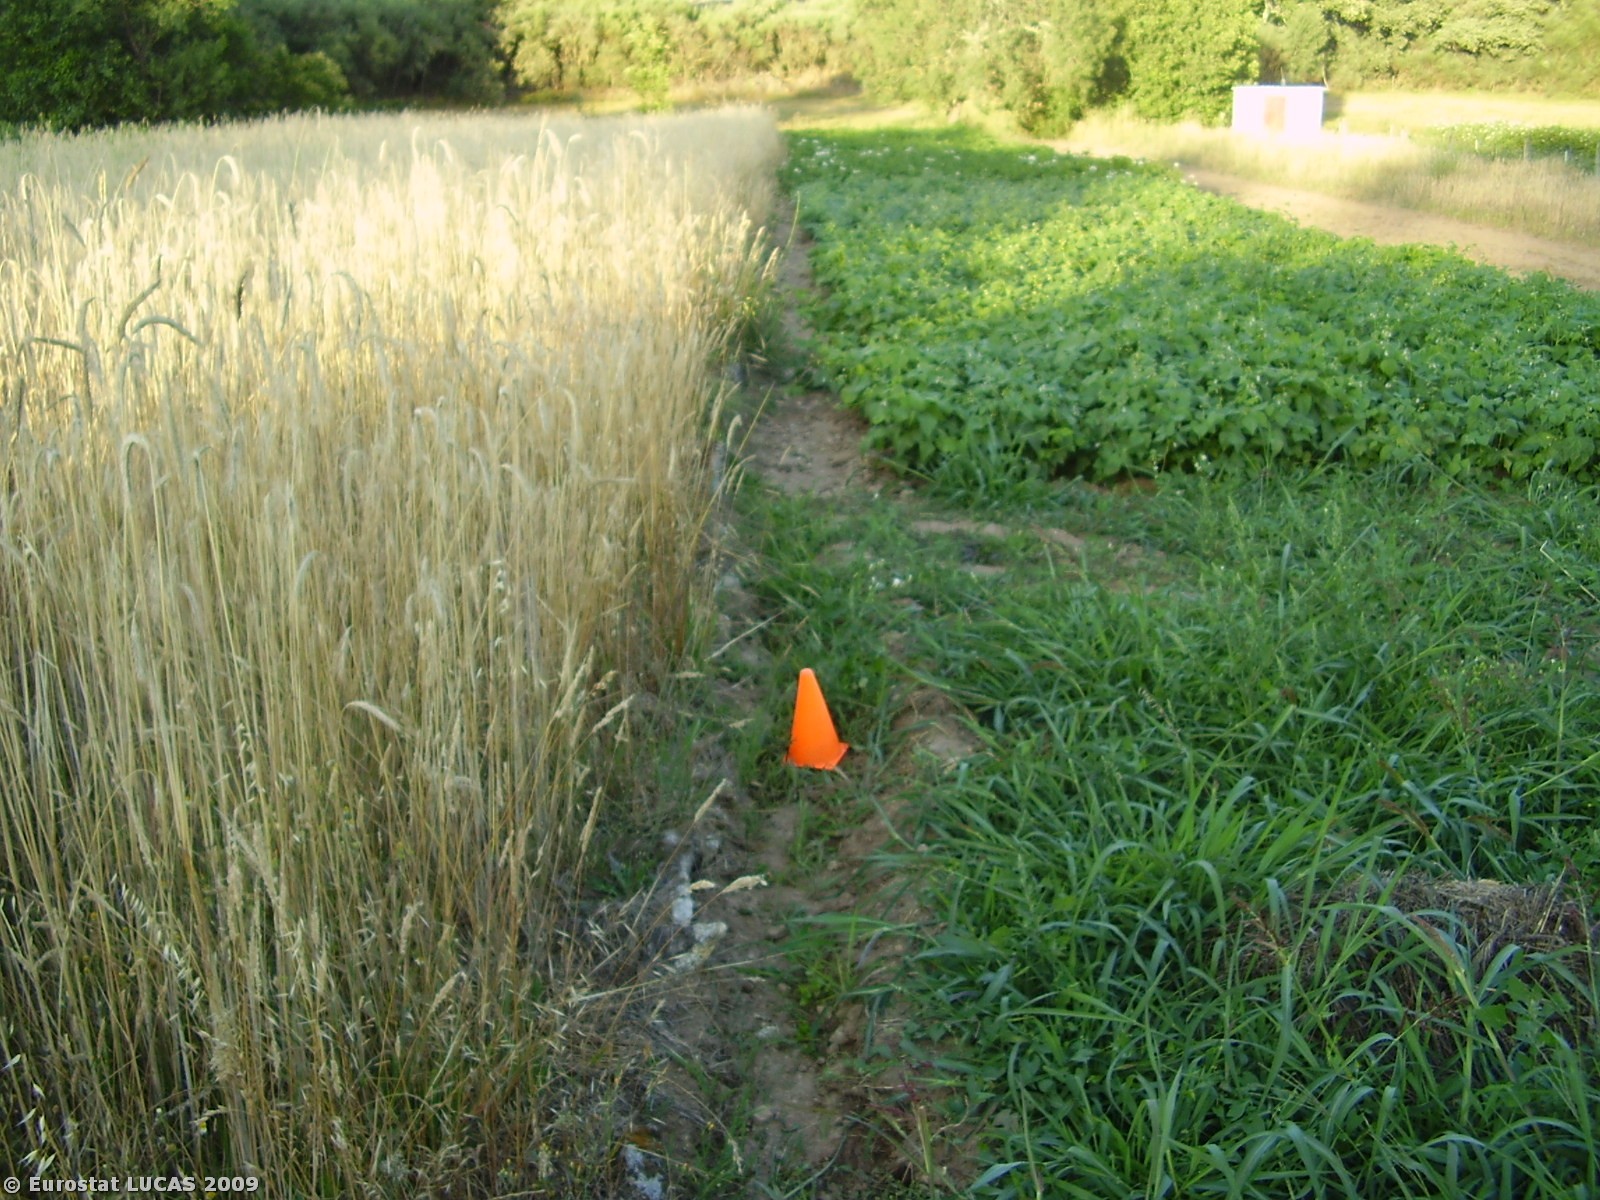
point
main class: Cropland
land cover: Mixed cereals for fodder
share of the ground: > 75 %
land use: Agriculture (excluding fallow land and kitchen gardens)
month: July
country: PT
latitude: 41.2889
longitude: -7.6694
